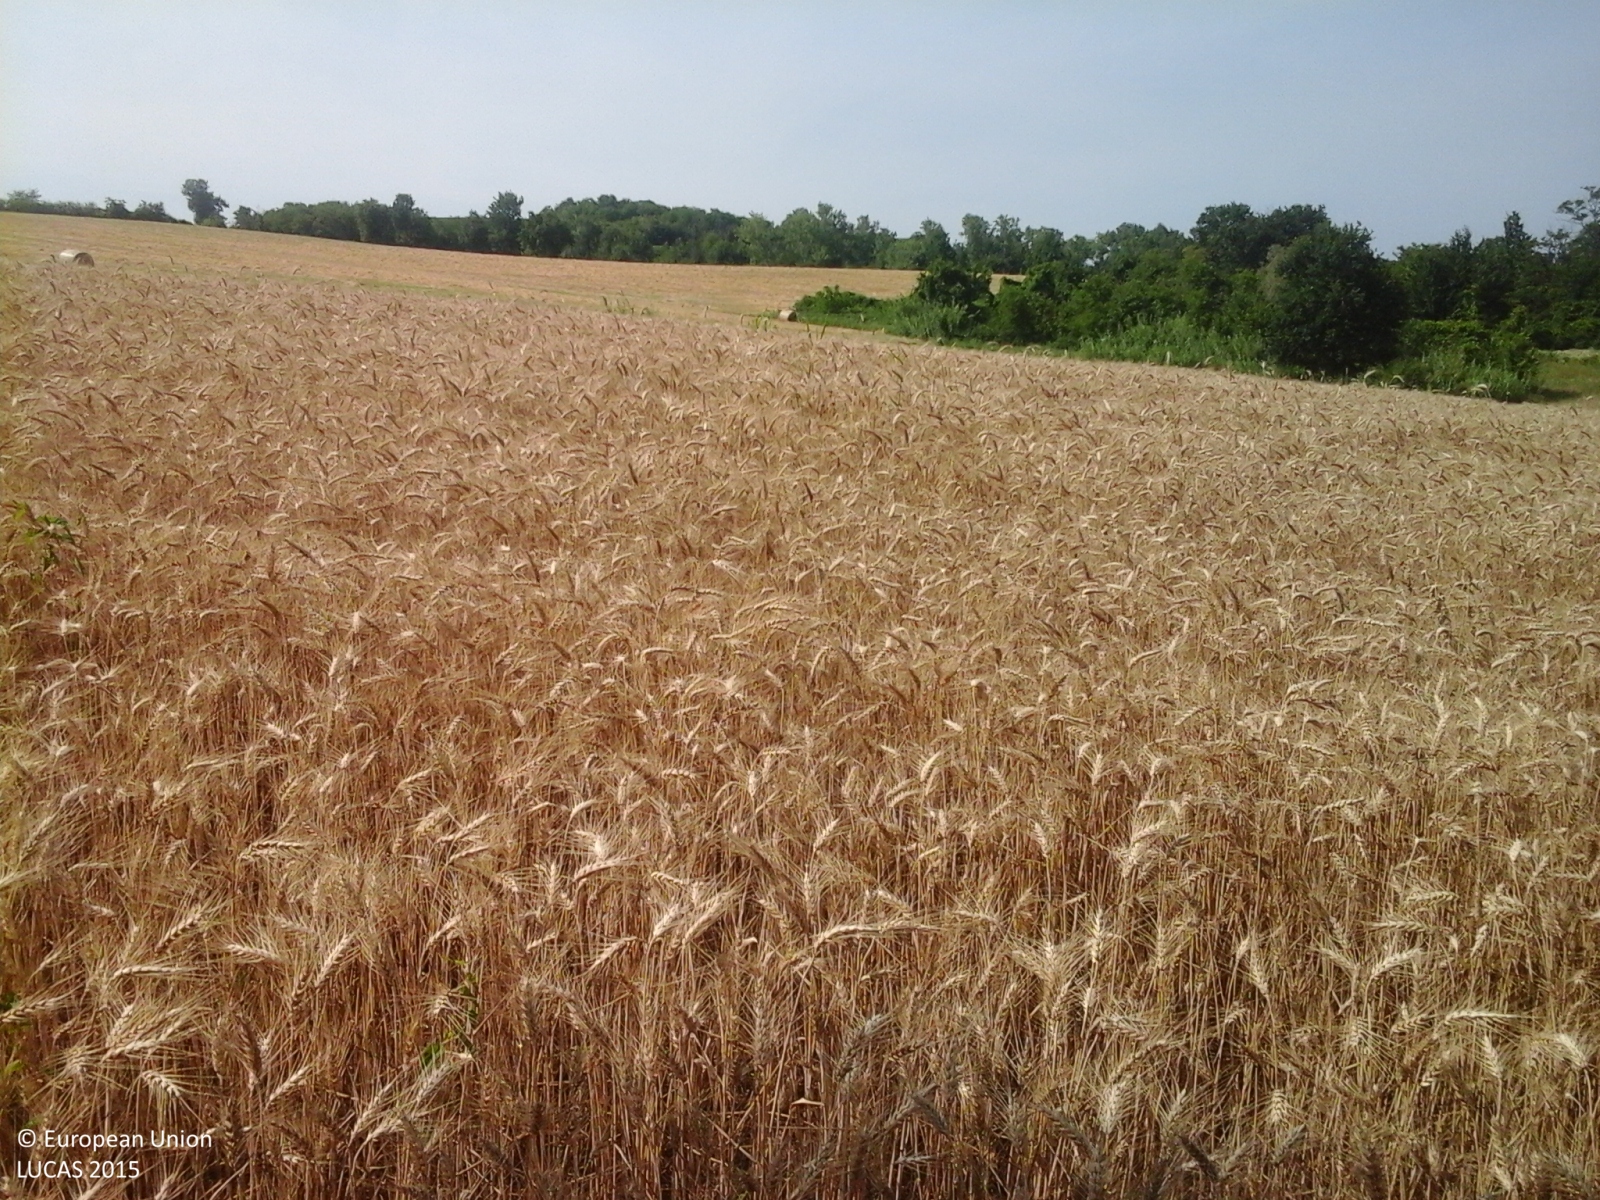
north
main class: Cropland
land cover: Common wheat
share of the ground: > 75 %
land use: Agriculture (excluding fallow land and kitchen gardens)
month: June
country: IT
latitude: 45.0062
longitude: 8.4424
